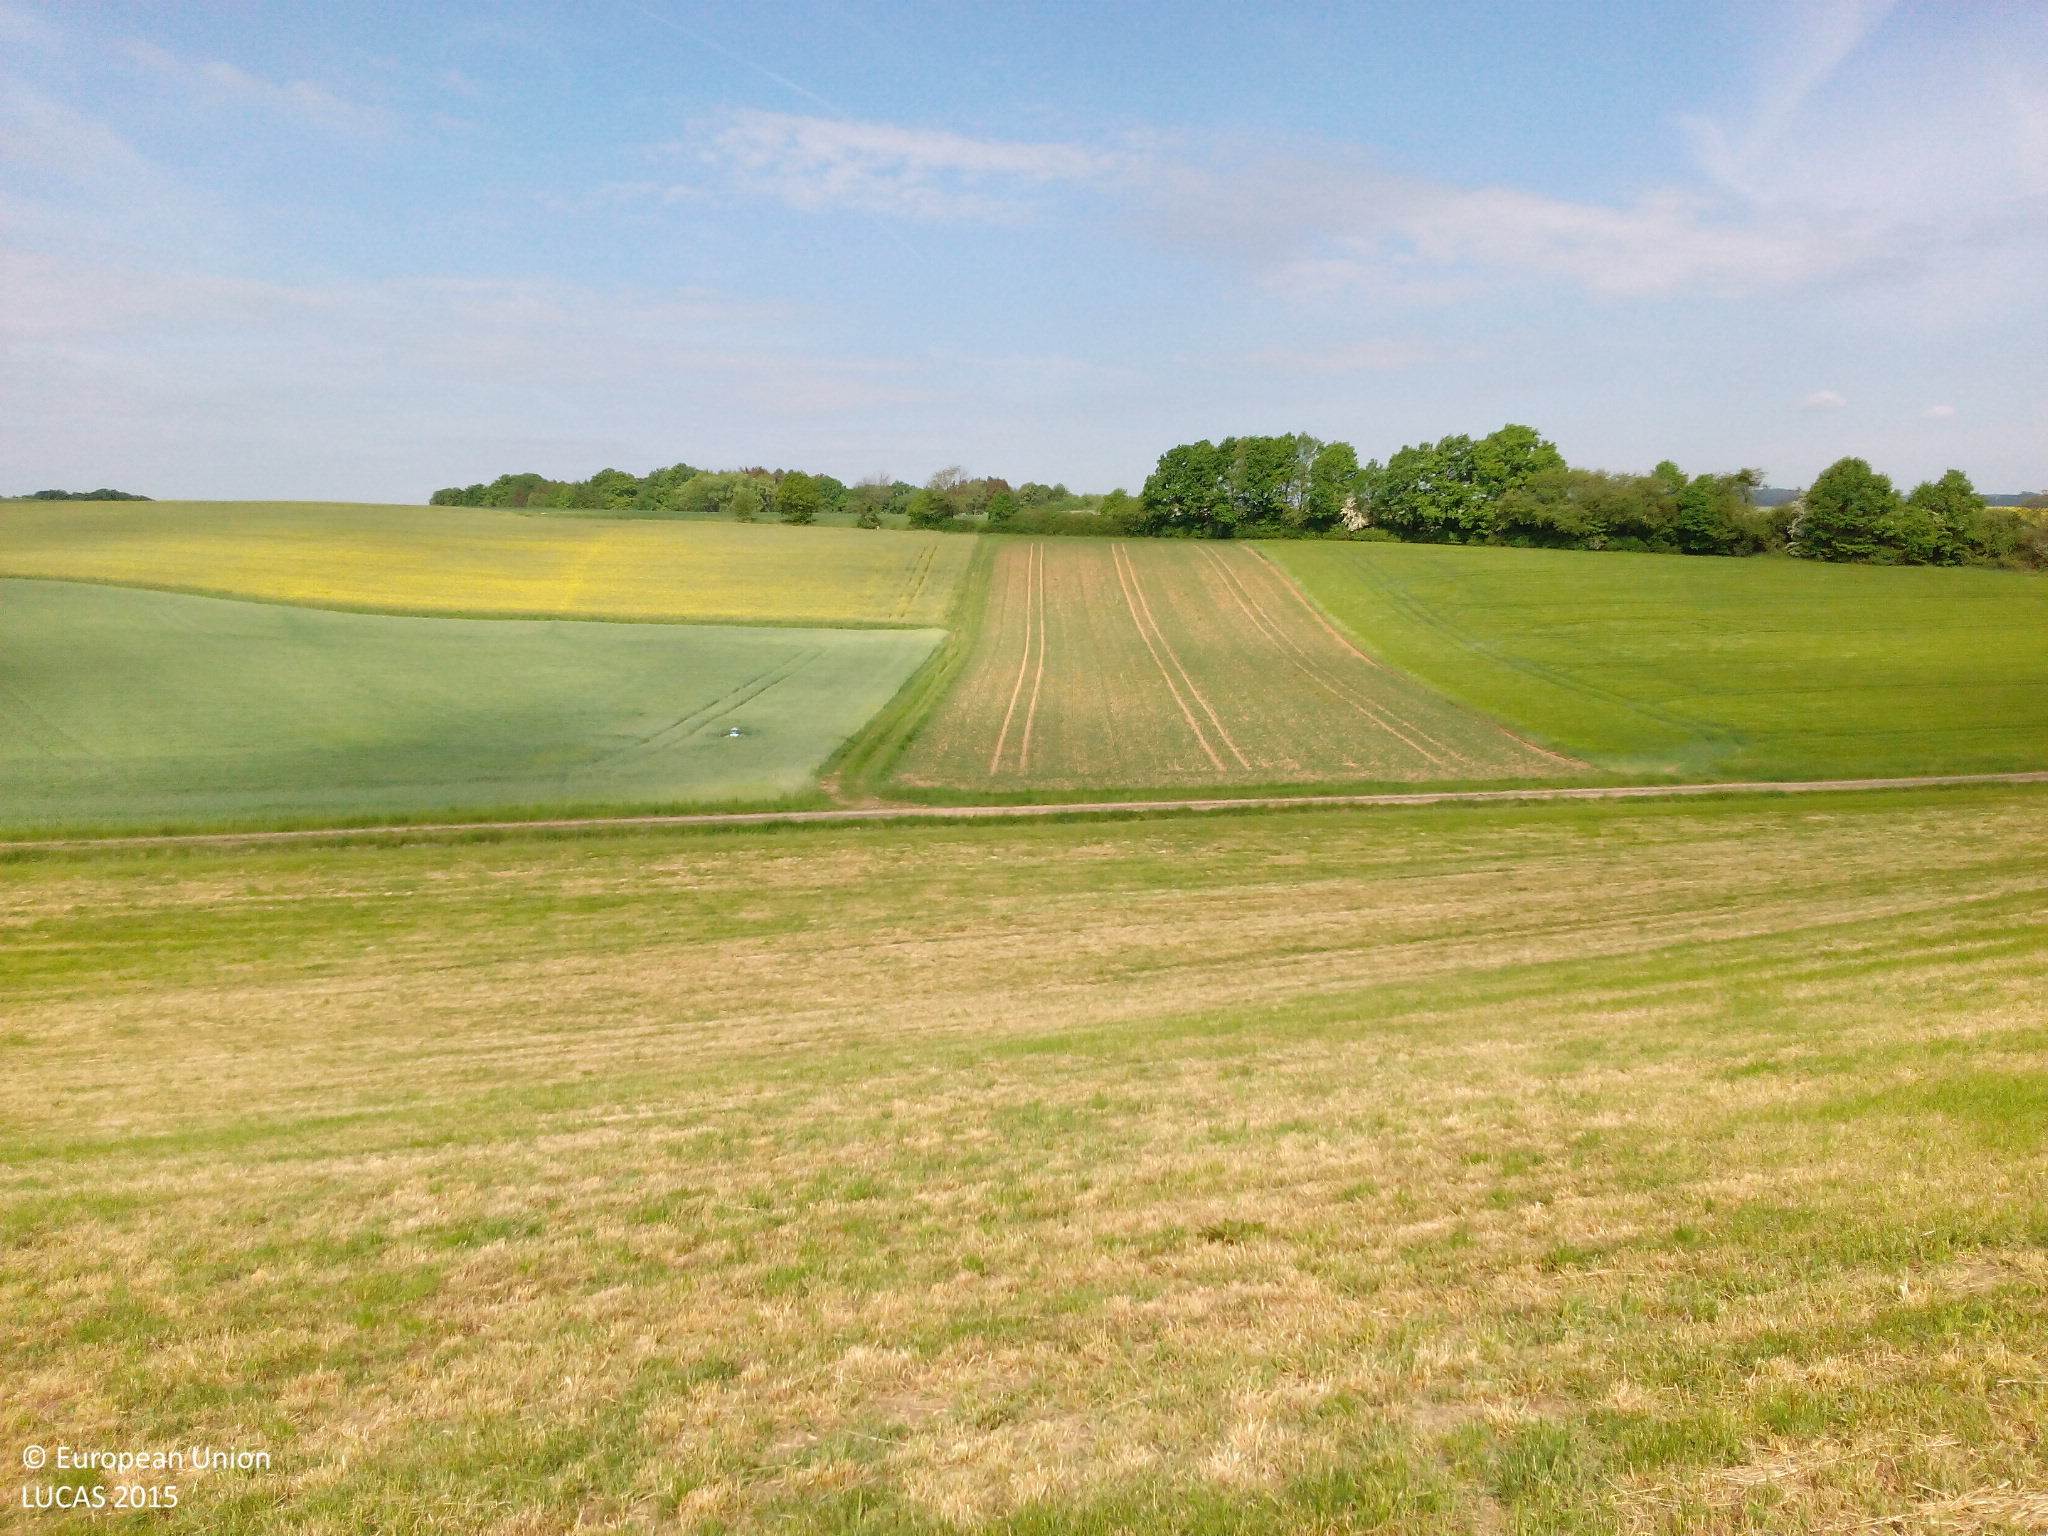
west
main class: Grassland
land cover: Grassland without tree/shrub cover
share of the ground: > 75 %
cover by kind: herbaceous plants 100 %
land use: Agriculture (excluding fallow land and kitchen gardens)
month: May
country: DE
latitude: 50.1444
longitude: 10.9373
